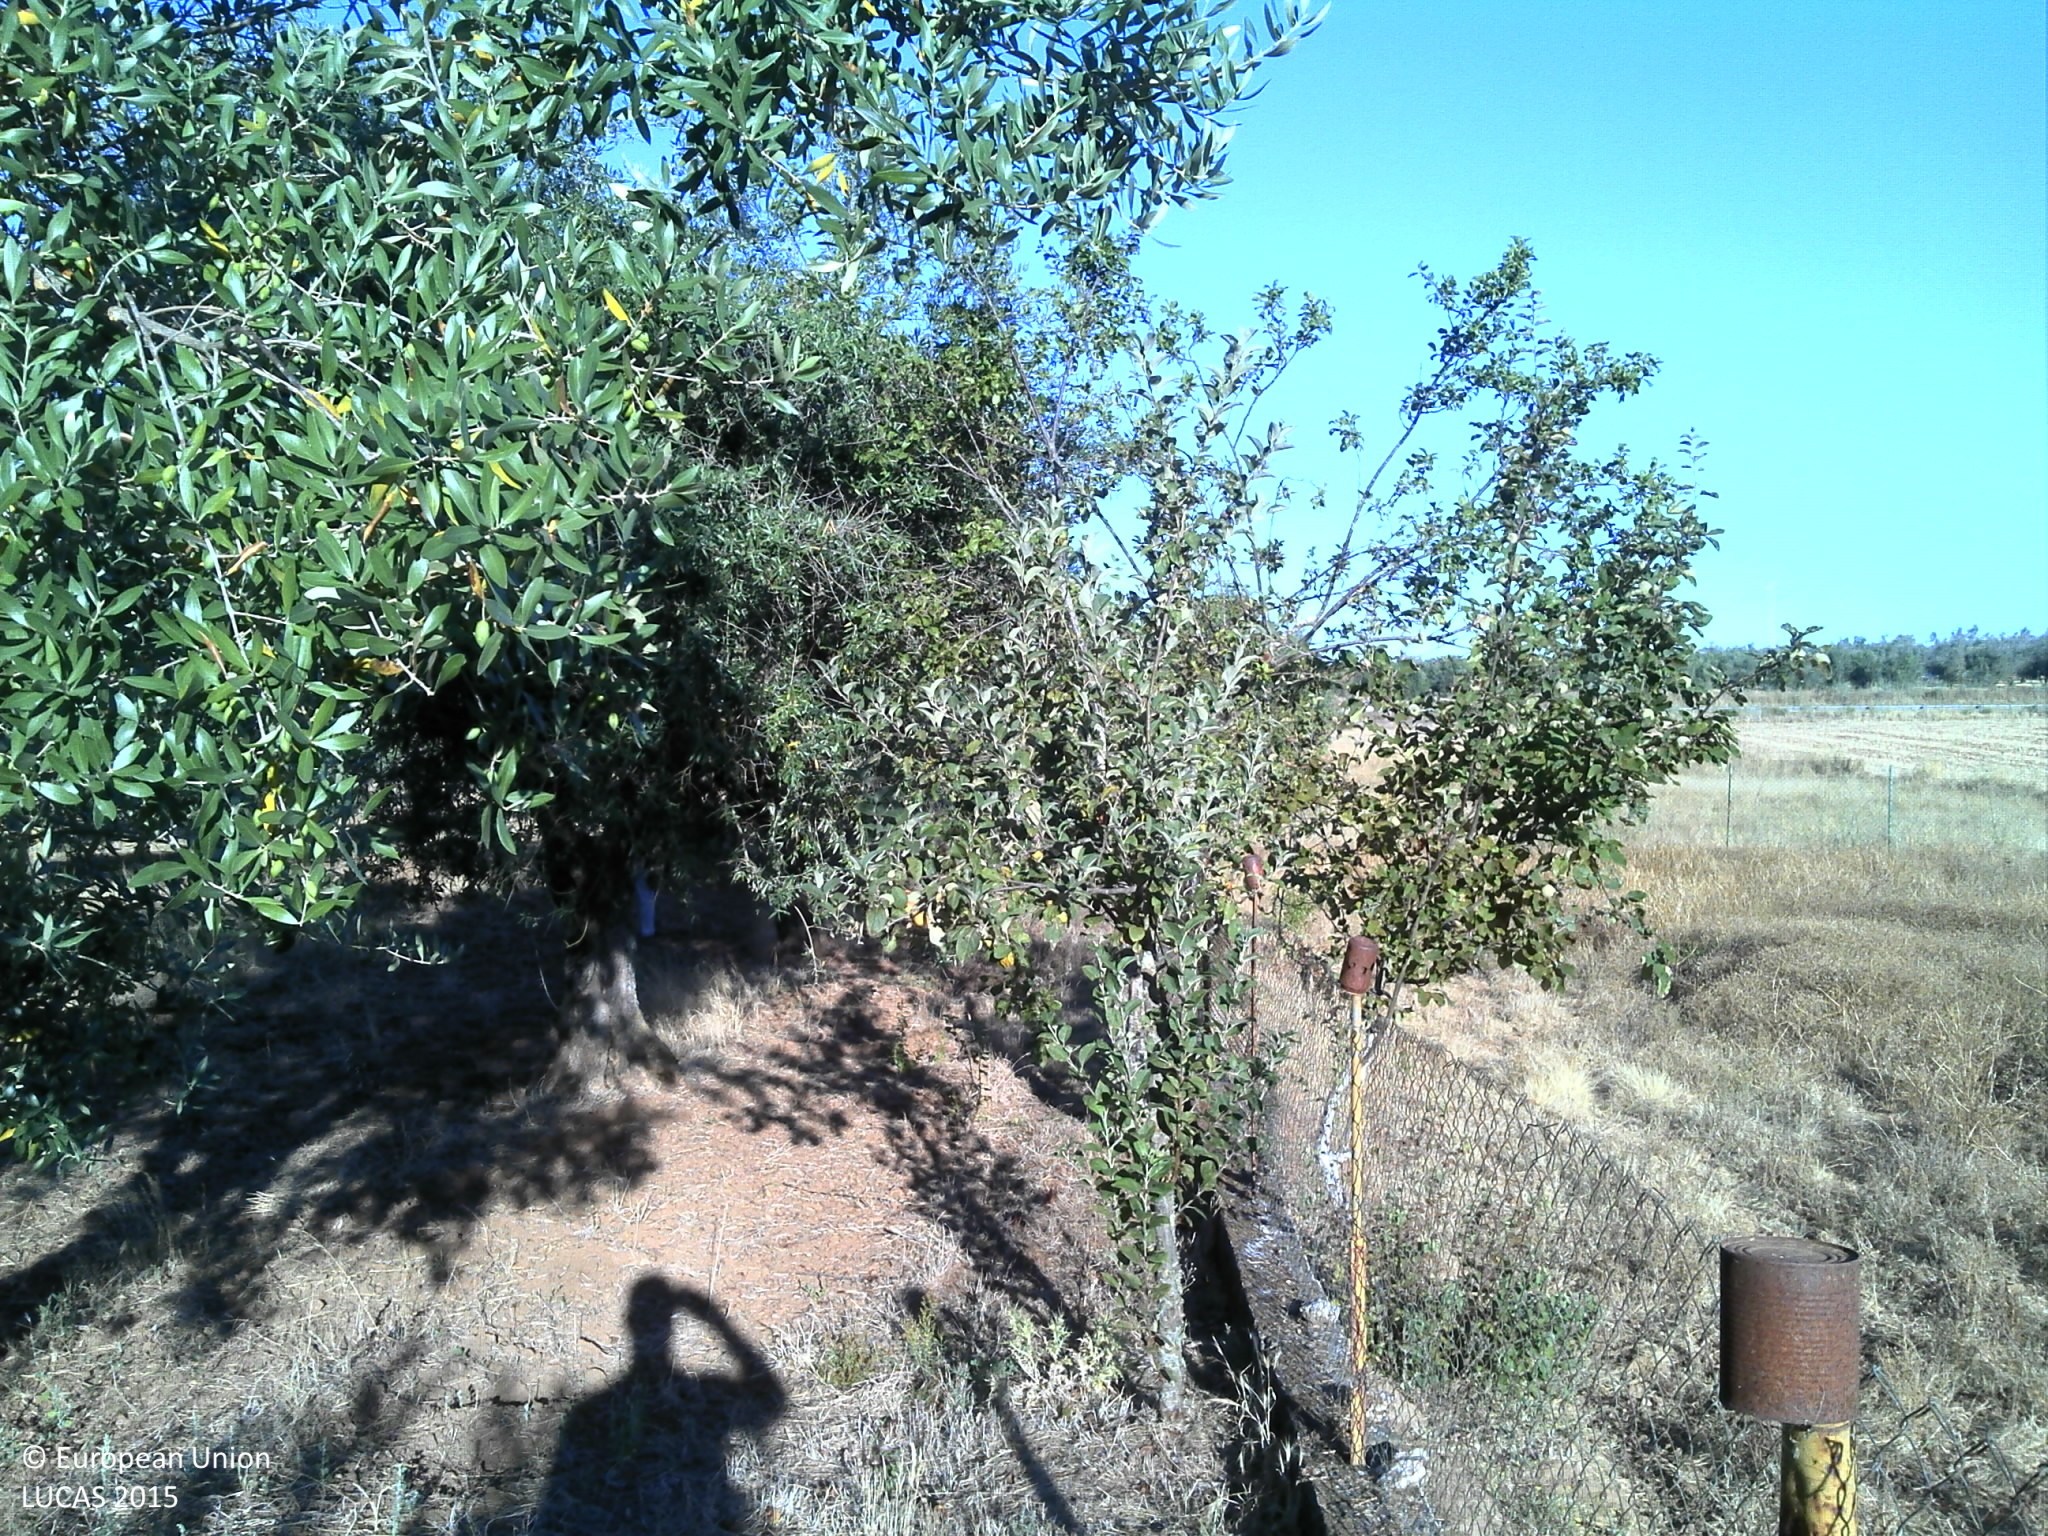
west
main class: Shrubland
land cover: Shrubland without tree cover
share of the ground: 50 - 75 %
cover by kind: unconsolidated bare surface 50 %, shrubs 25 %, herbaceous plants 25 %
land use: Fallow land
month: July
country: PT
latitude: 38.8929
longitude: -7.5501
